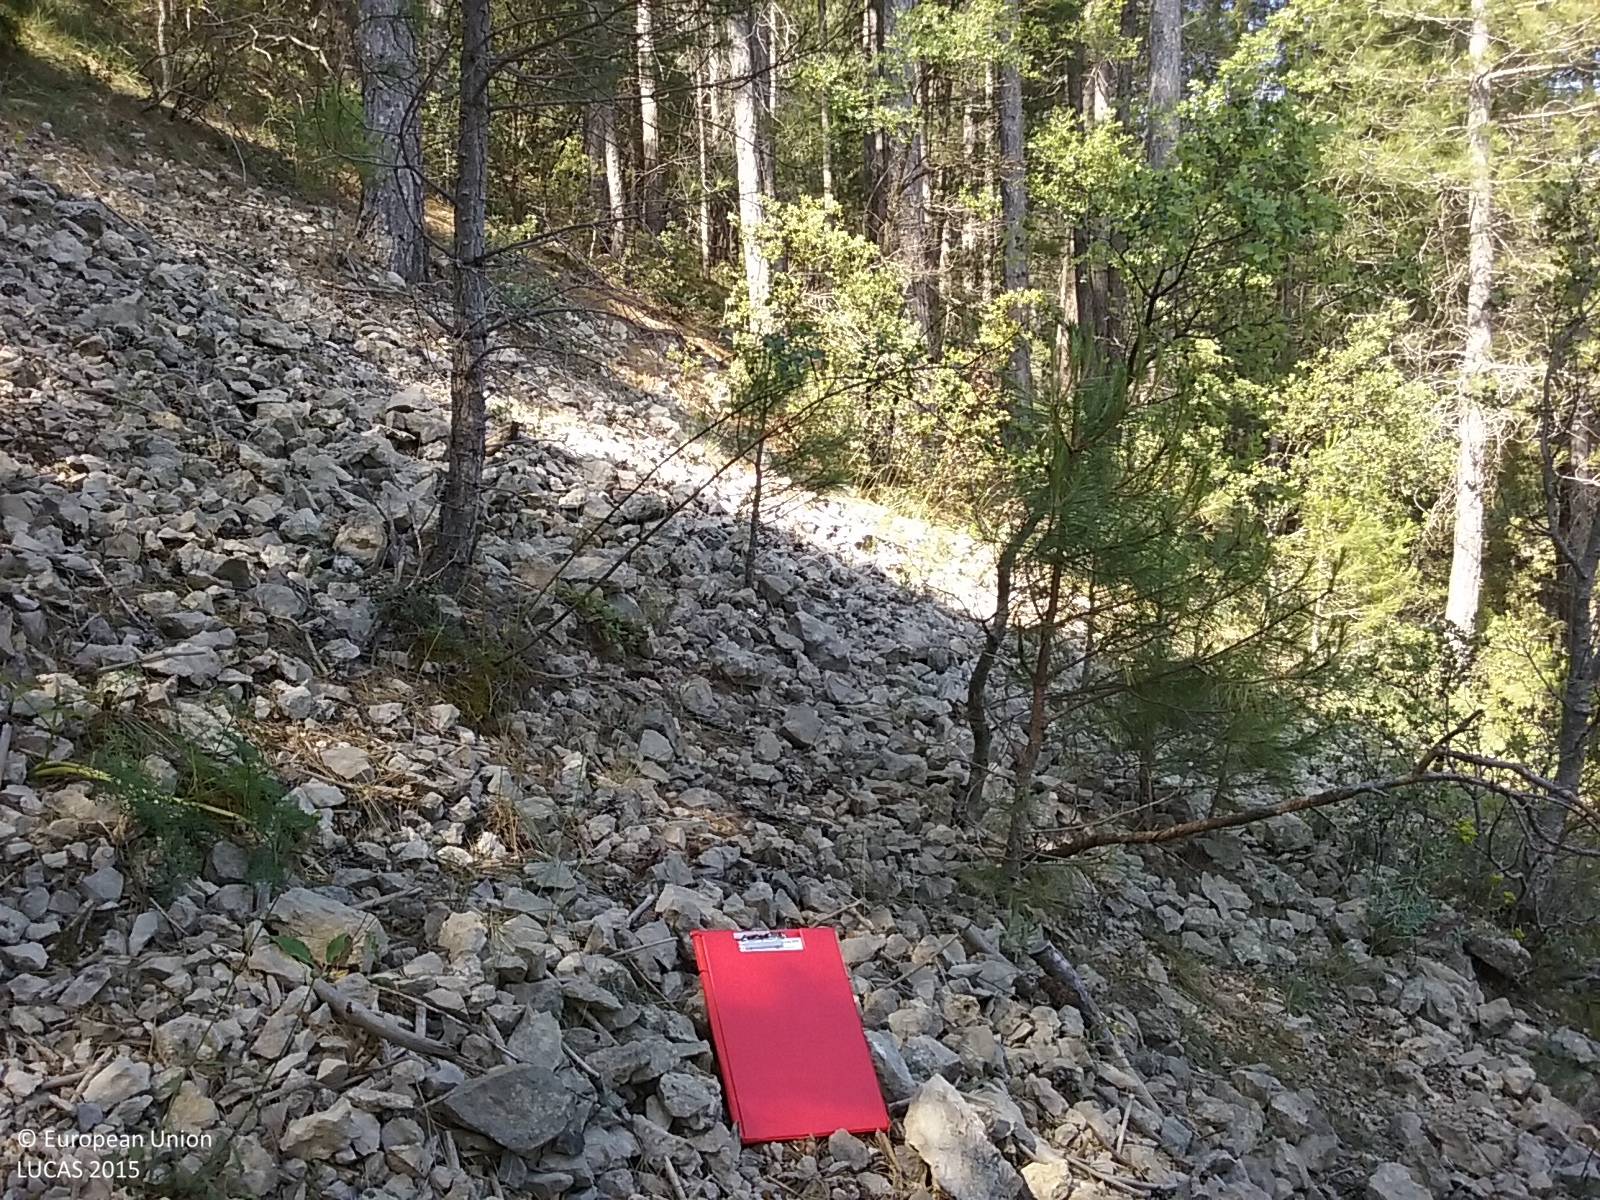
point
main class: Woodland
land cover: Pine dominated mixed woodland
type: coniferous forest of the mediterranean region
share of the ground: > 75 %
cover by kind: coniferous forest trees 45 %, broadleaved forest trees 35 %, herbaceous plants 10 %, shrubs 5 %, unconsolidated bare surface 5 %
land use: Forestry
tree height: > 5 m
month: June
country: ES
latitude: 40.7014
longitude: -0.0084
